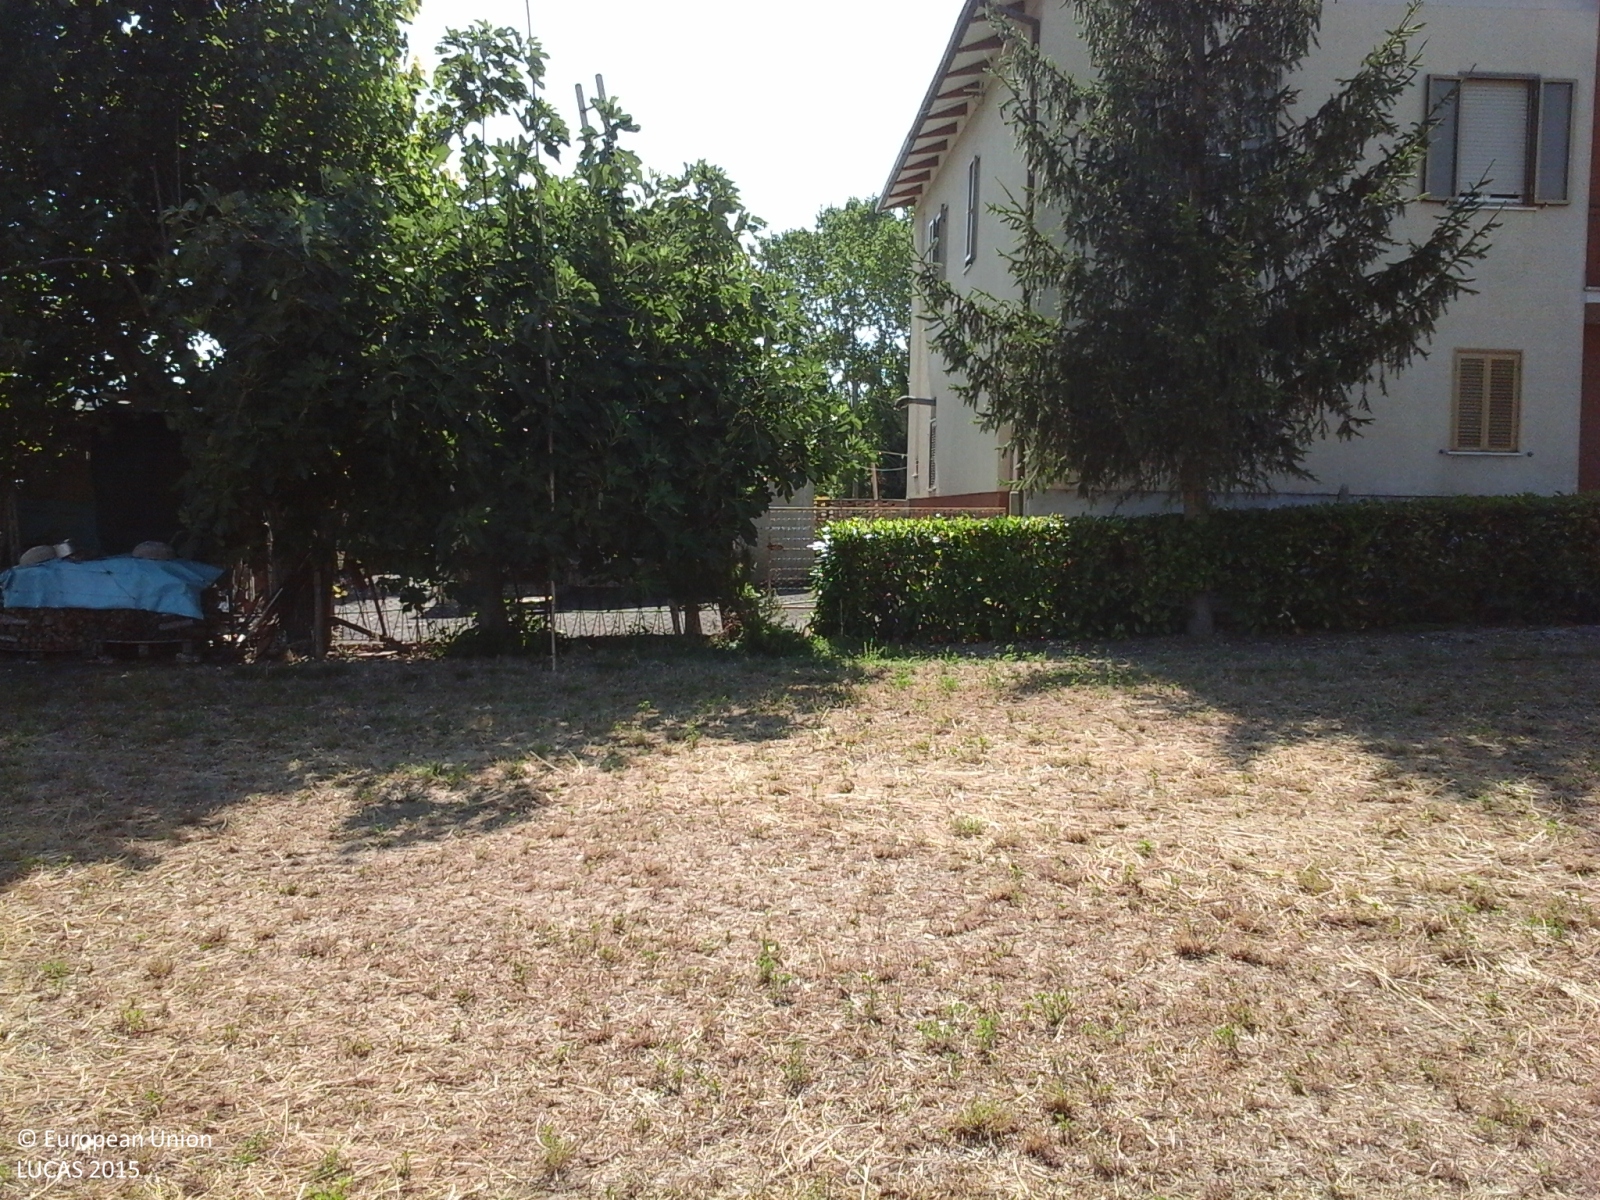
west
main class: Cropland
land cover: Lucerne
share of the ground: > 75 %
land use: Agriculture (excluding fallow land and kitchen gardens)
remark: Harvested field
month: July
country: IT
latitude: 43.3949
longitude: 13.3127
